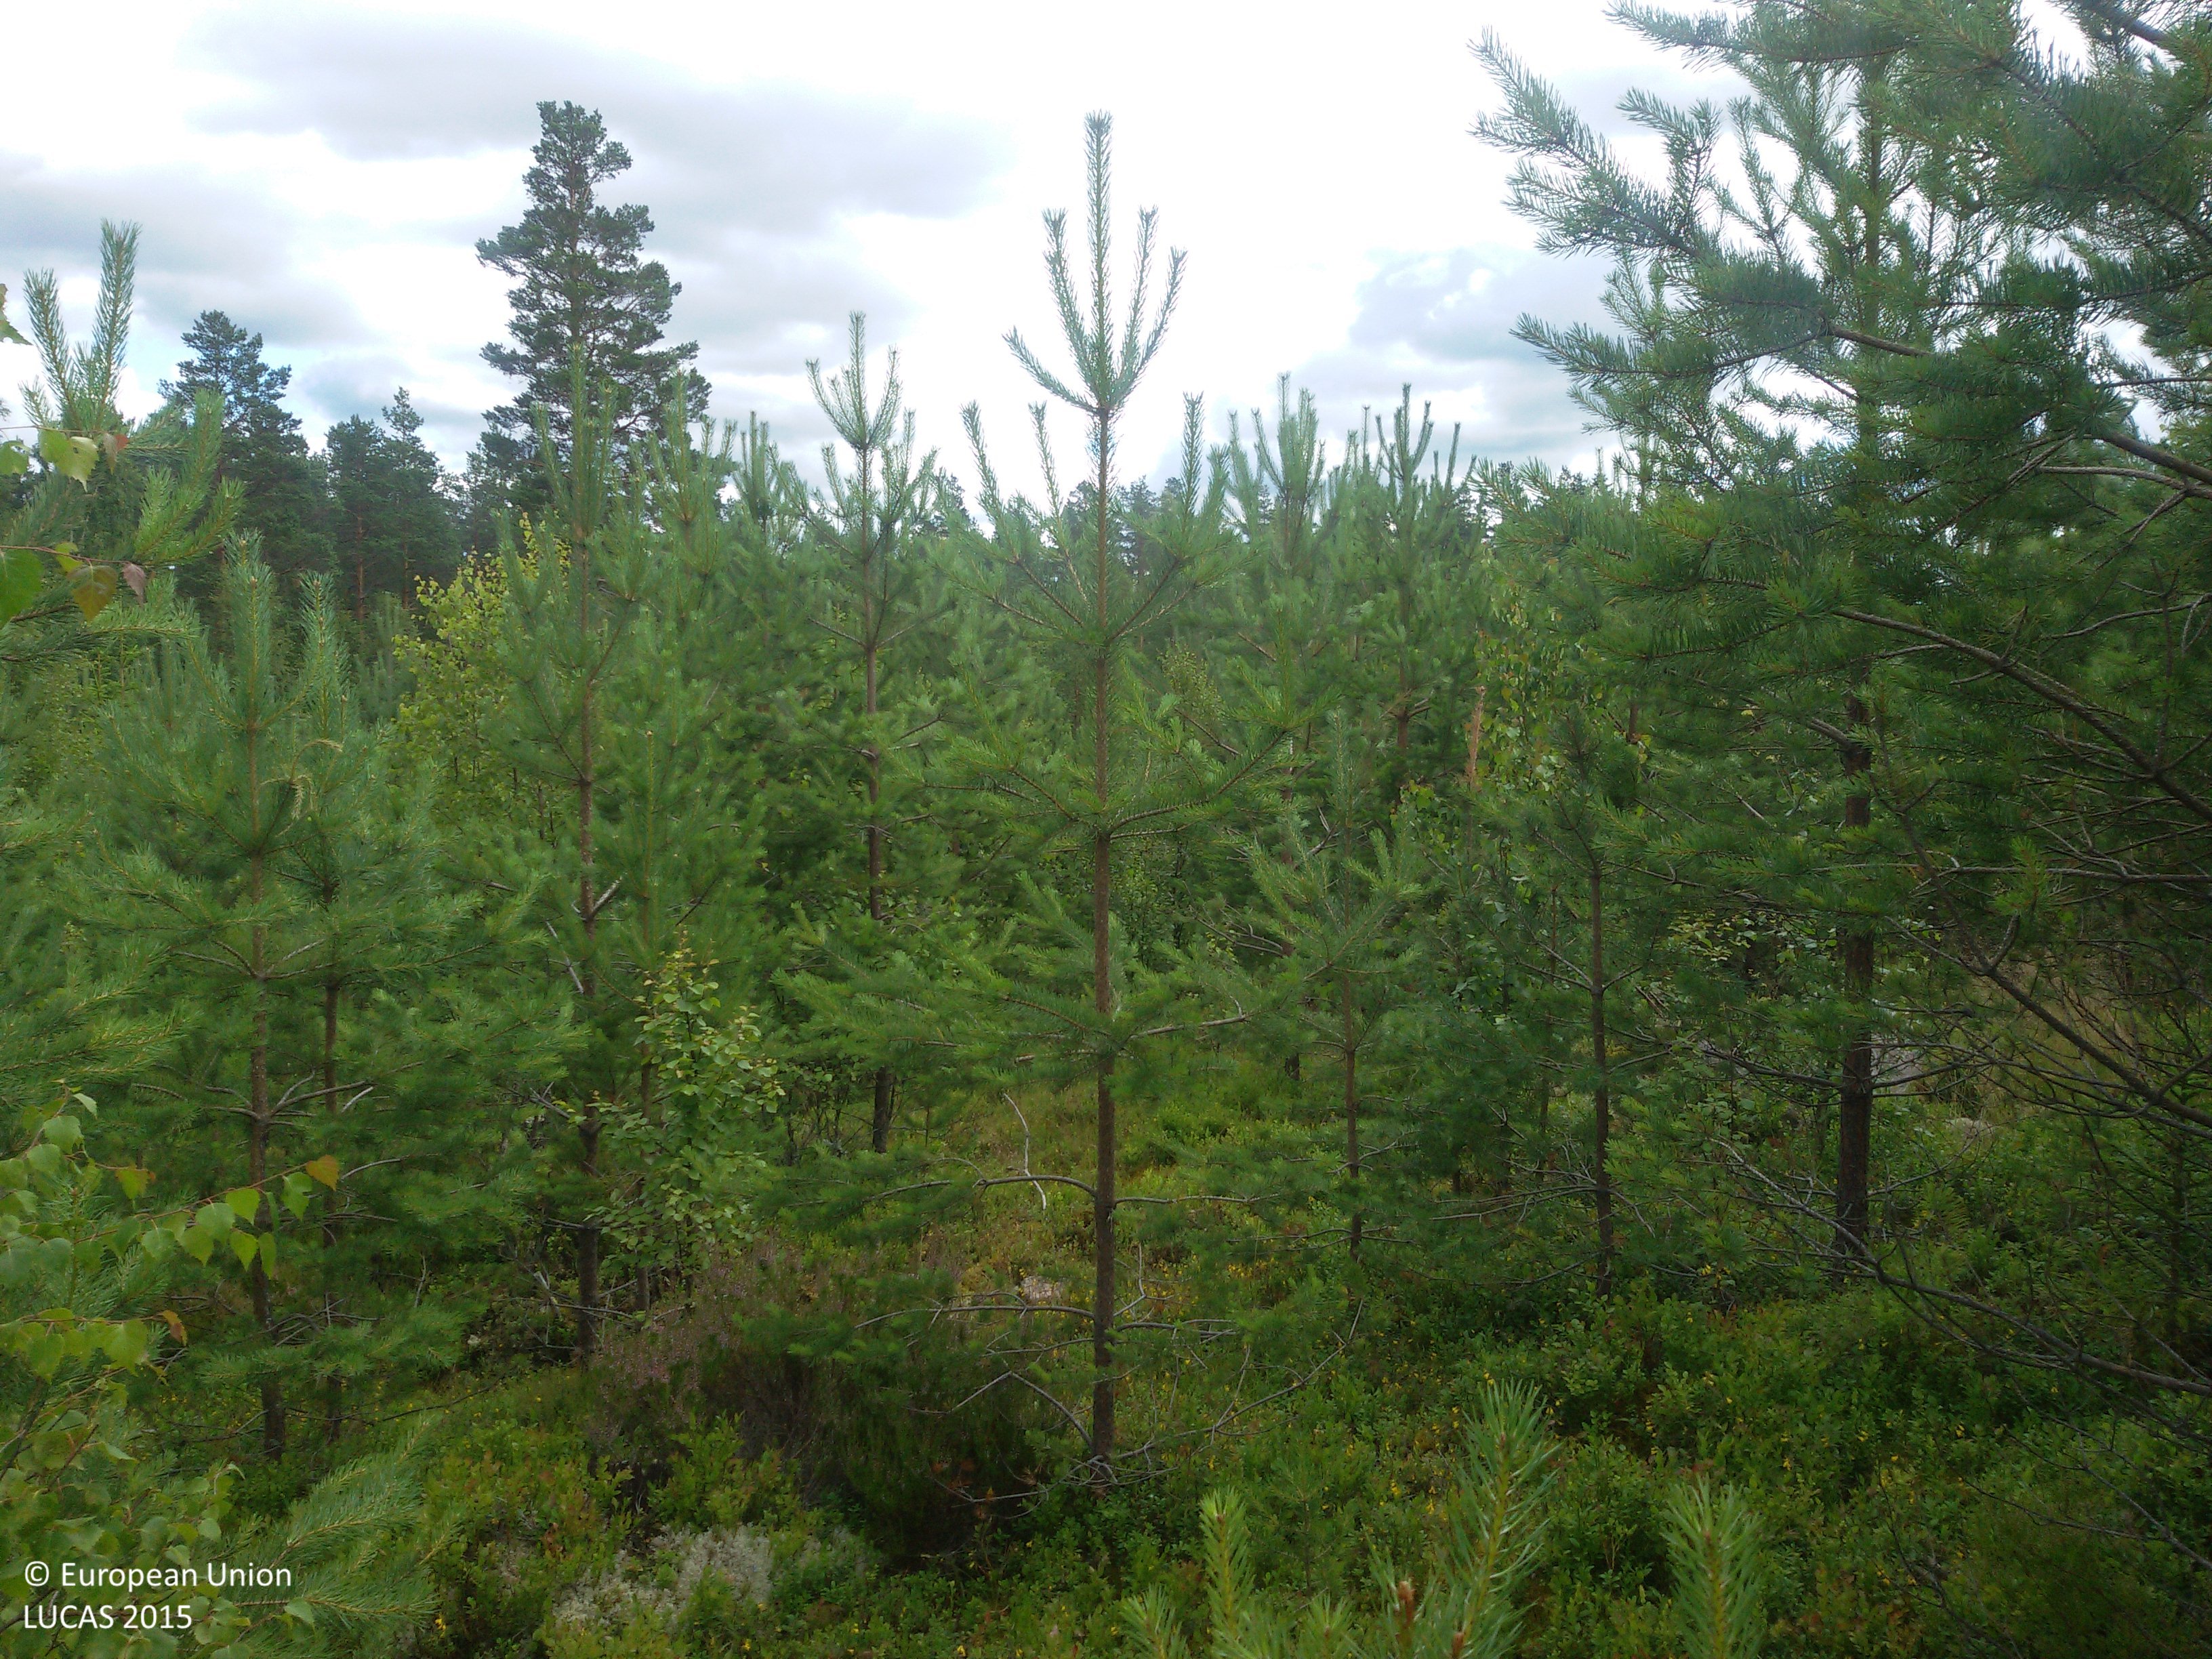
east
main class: Woodland
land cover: Pine dominated mixed woodland
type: boreal forest
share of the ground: > 75 %
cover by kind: coniferous forest trees 50 %, broadleaved forest trees 30 %, shrubs 15 %, lichens and mosses 5 %
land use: Forestry
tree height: < 5 m
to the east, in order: Pine dominated mixed woodland; Tracks; Pine dominated mixed woodland; Pine dominated coniferous woodland; Rivers and streams; Pine dominated coniferous woodland
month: July
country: SE
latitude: 60.5279
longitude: 15.8732
